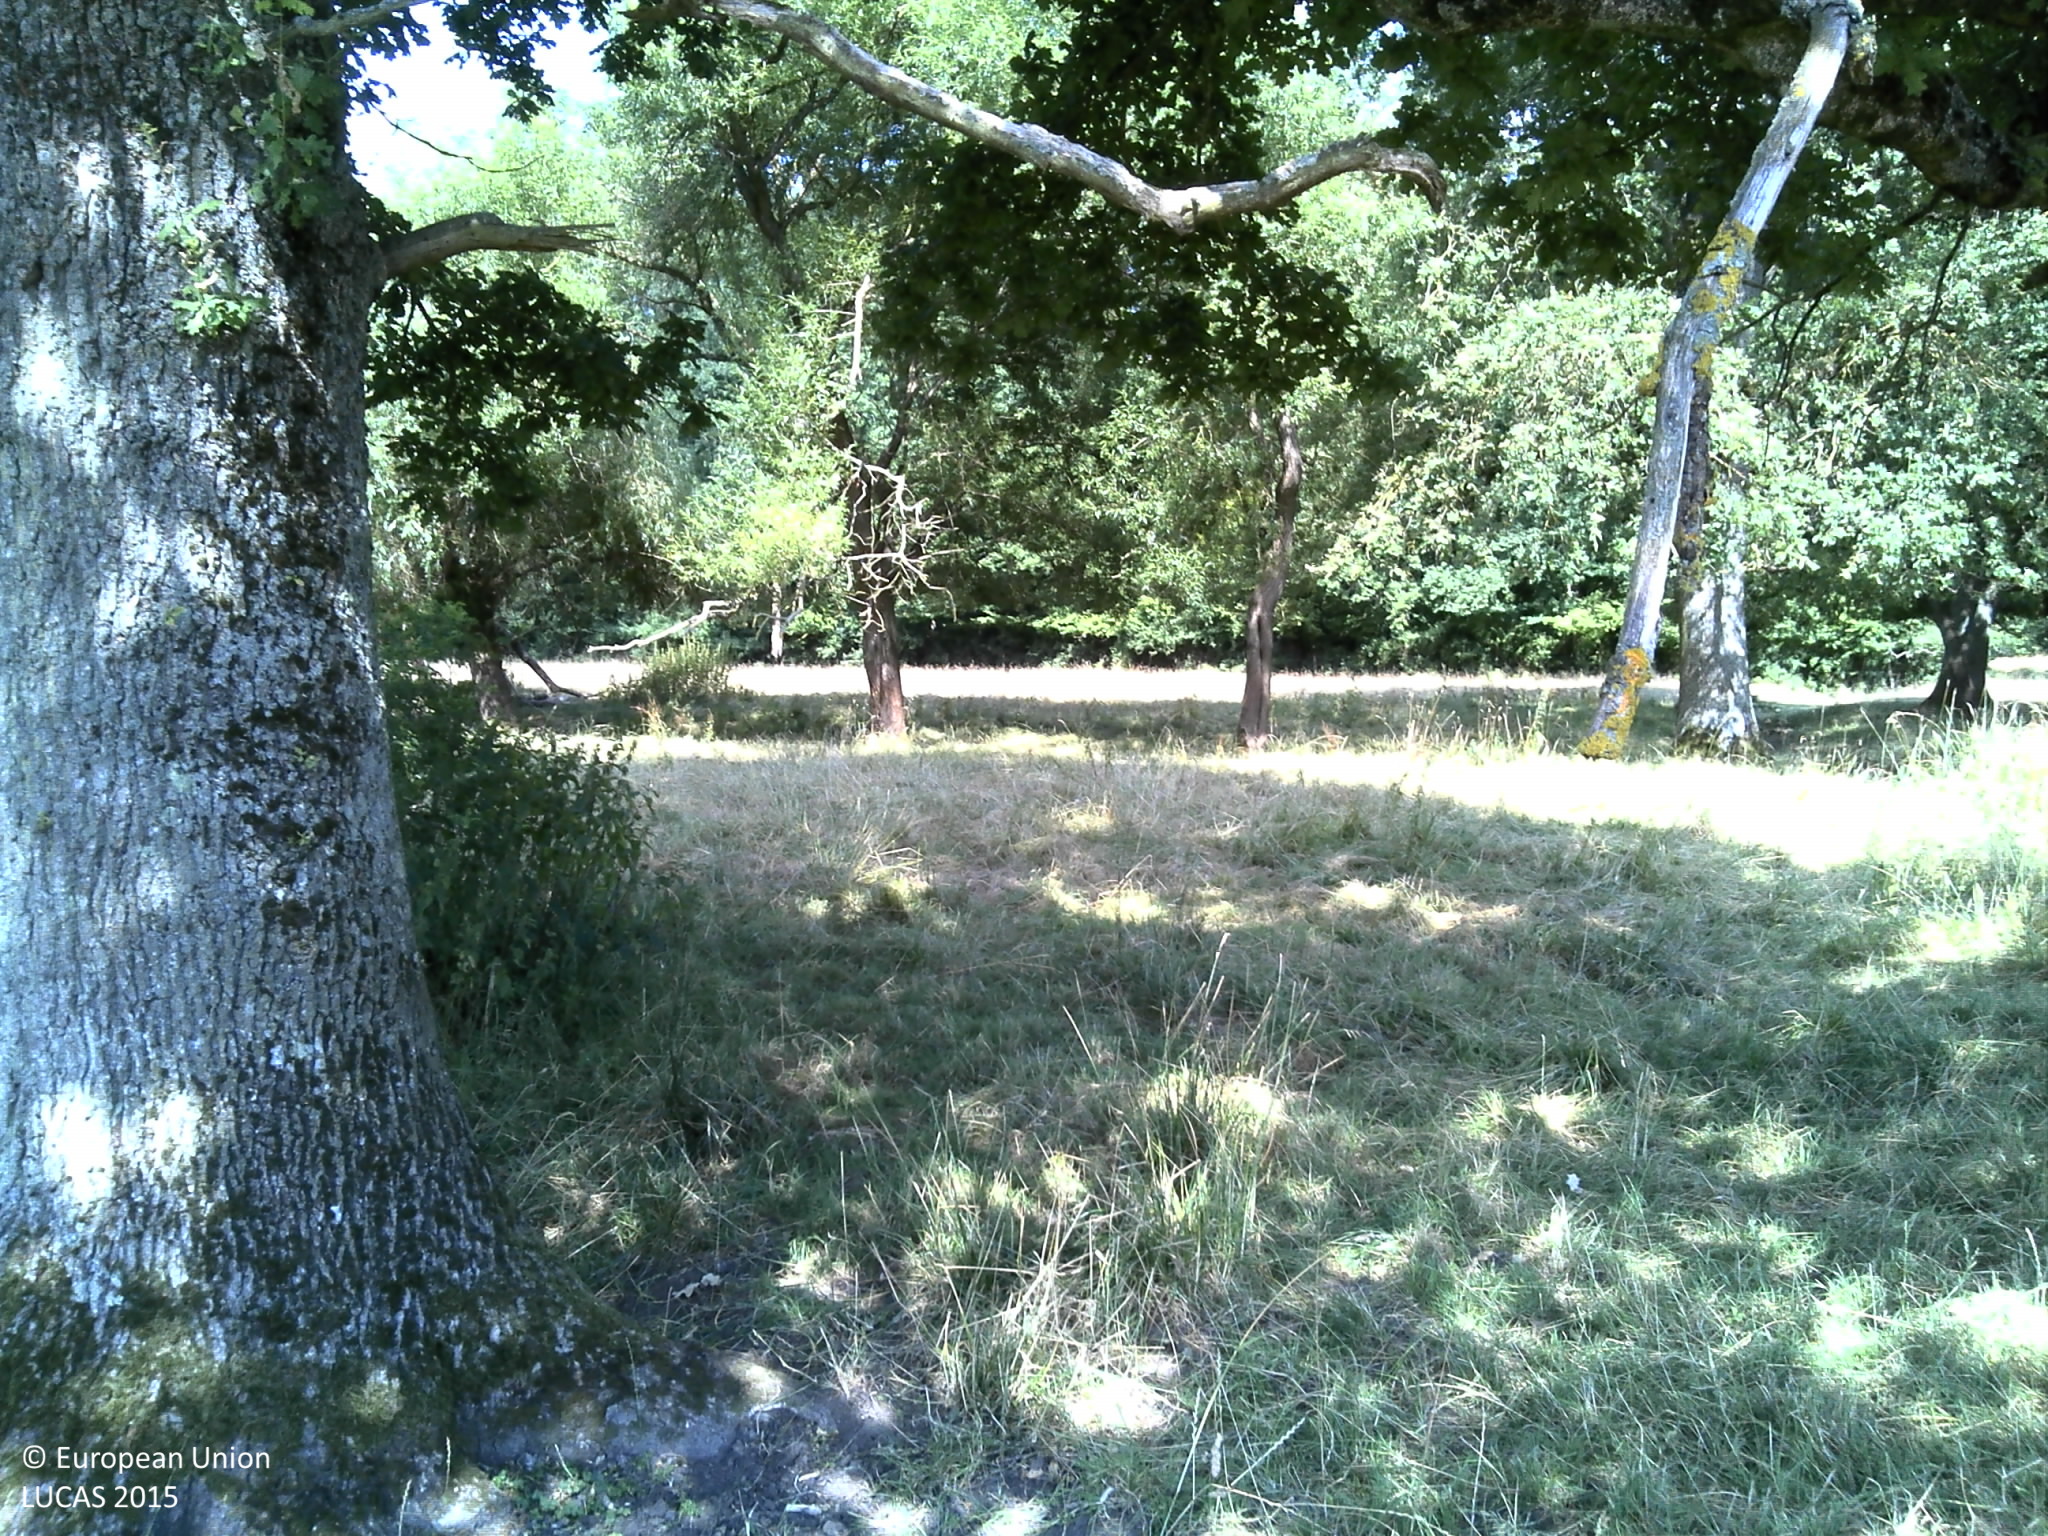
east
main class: Grassland
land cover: Grassland without tree/shrub cover
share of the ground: > 75 %
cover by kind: herbaceous plants 100 %
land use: Agriculture (excluding fallow land and kitchen gardens)
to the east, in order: Grassland without tree/shrub cover; Broadleaved woodland; Grassland without tree/shrub cover; Broadleaved woodland
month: July
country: FR
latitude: 48.6764
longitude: 4.7690
